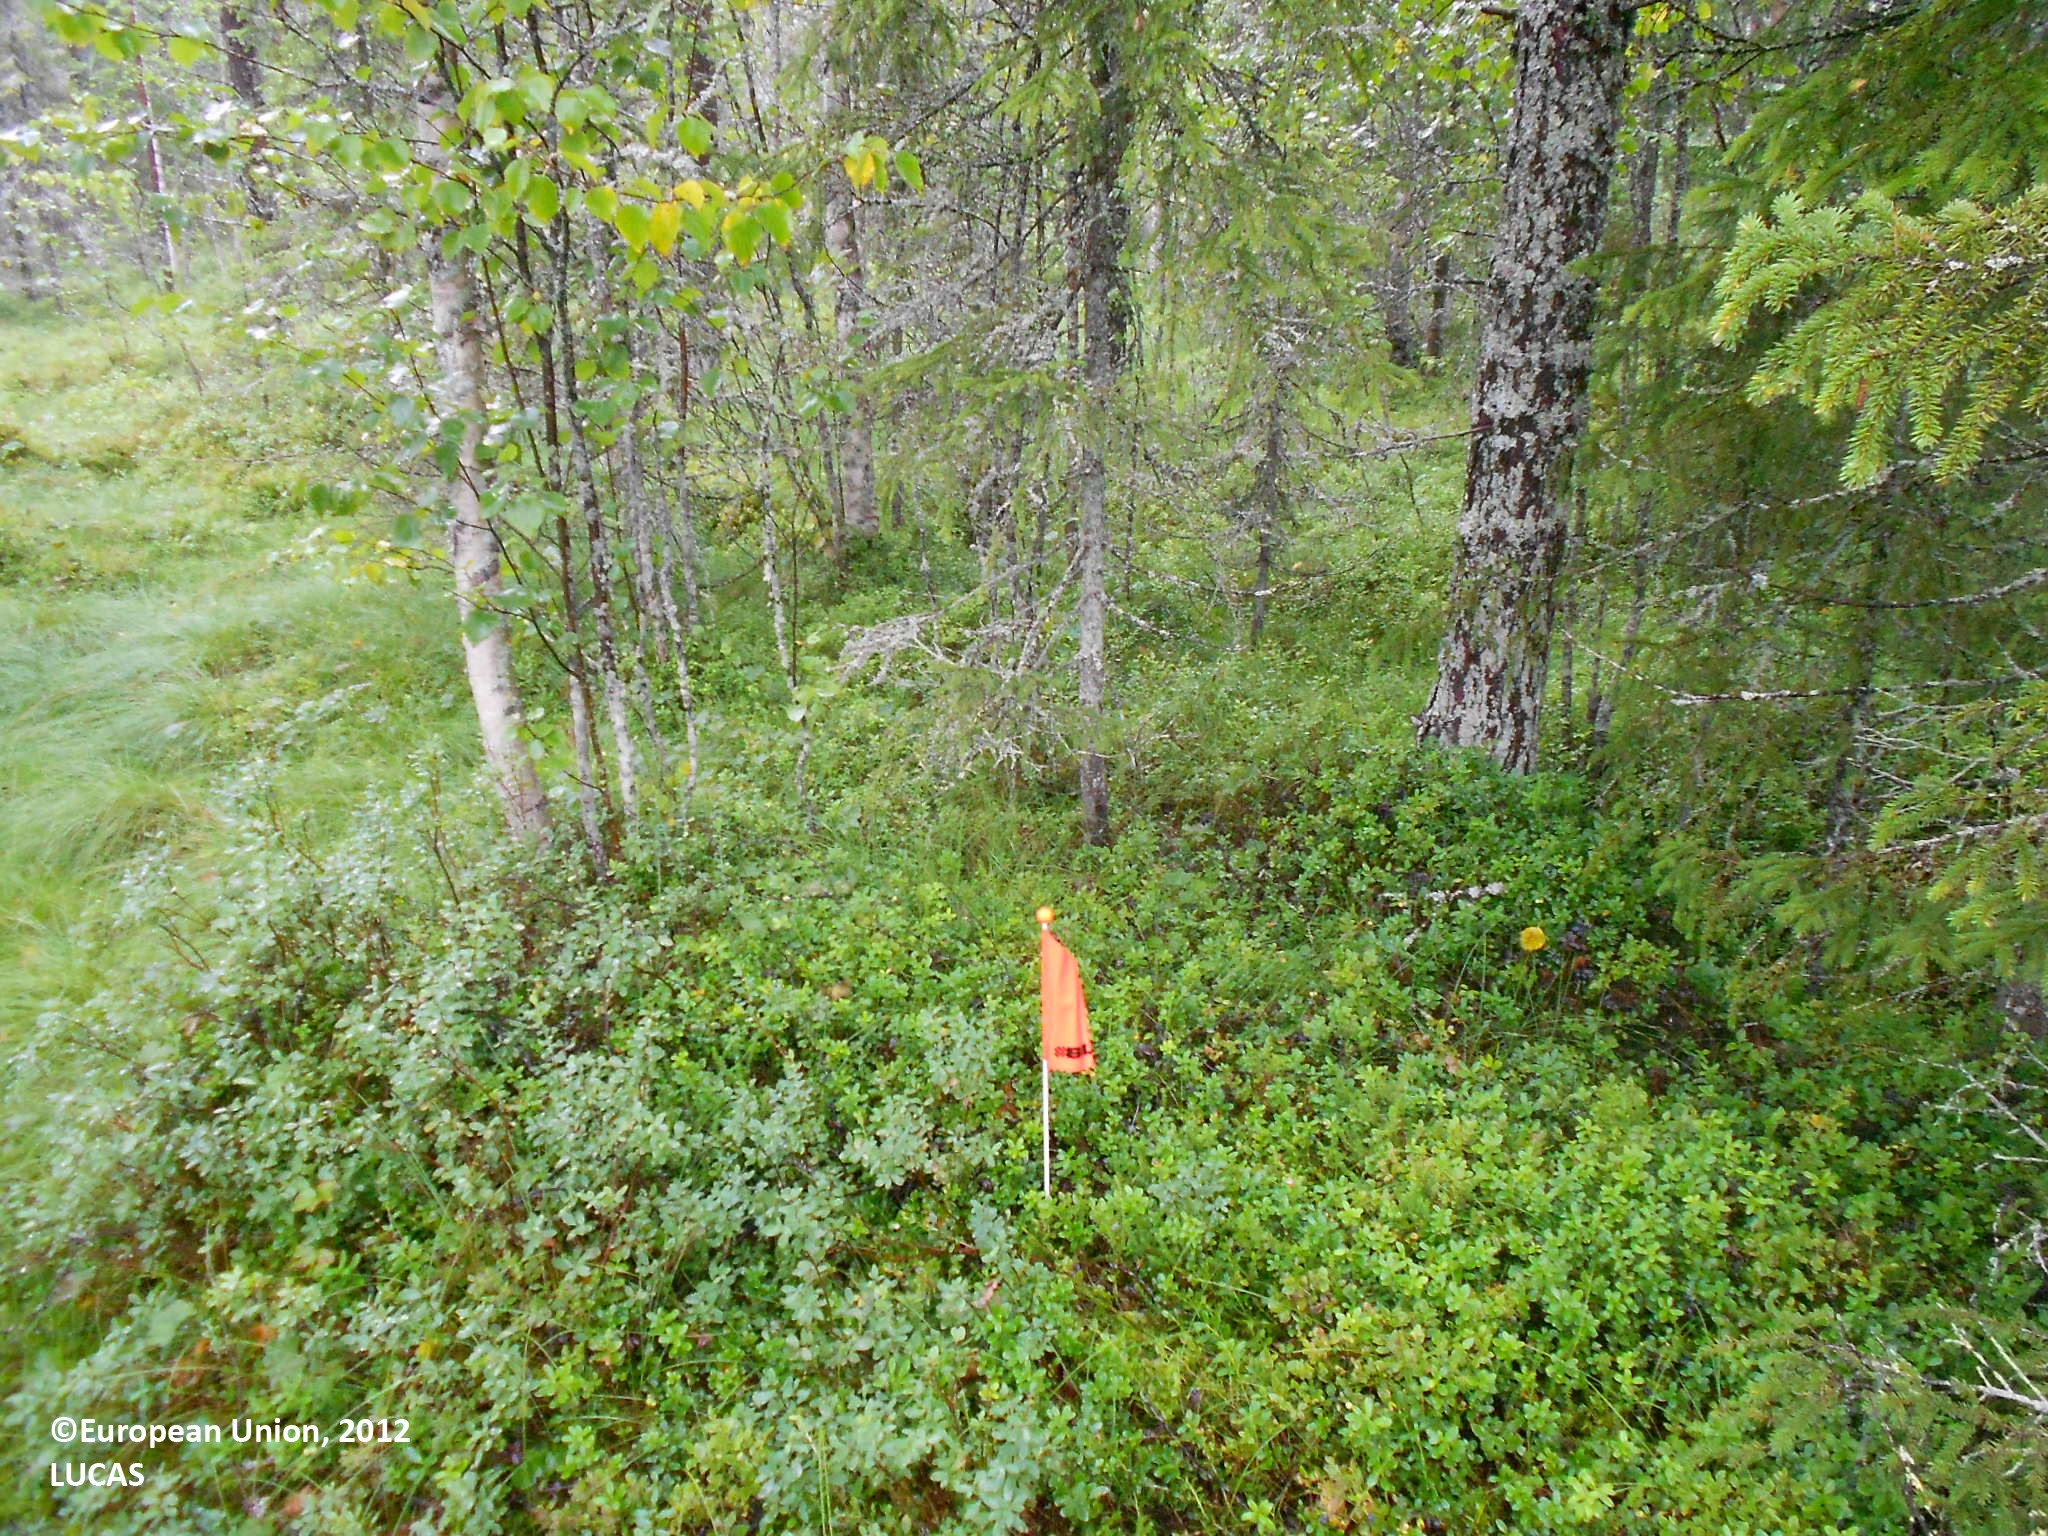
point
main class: Woodland
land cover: Pine dominated mixed woodland
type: boreal forest
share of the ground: 50 - 75 %
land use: Forestry
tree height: > 5 m
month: August
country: FI
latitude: 63.9250
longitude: 28.2203
